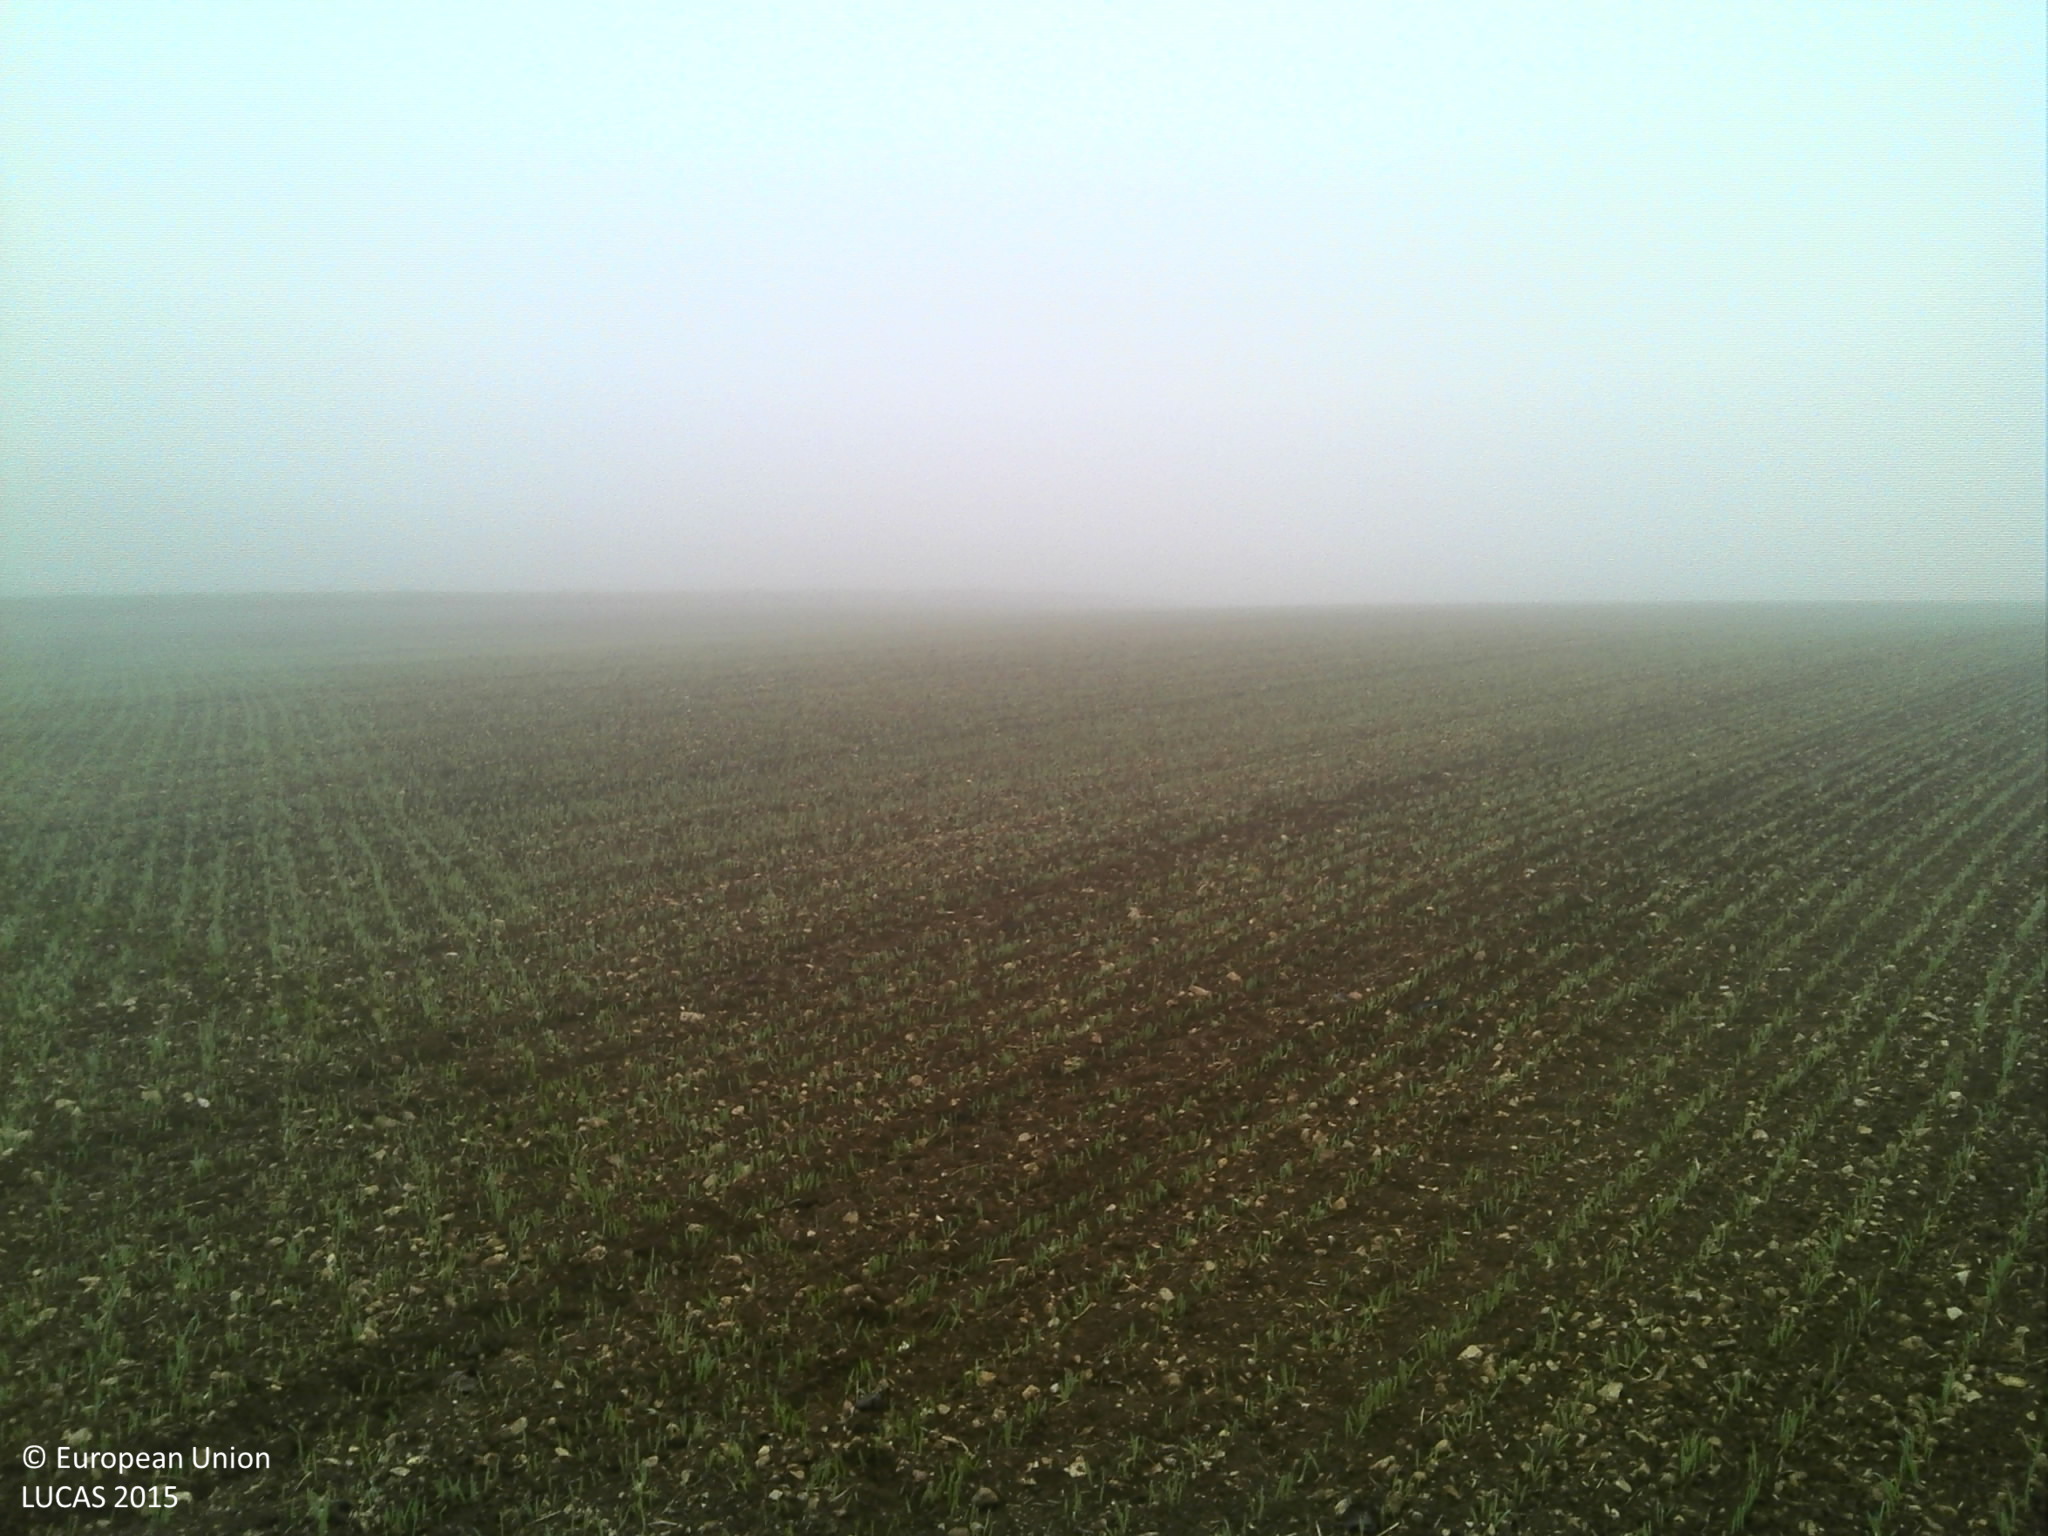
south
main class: Cropland
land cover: Common wheat
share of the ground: 10 - 25 %
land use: Agriculture (excluding fallow land and kitchen gardens)
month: October
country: FR
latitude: 47.4299
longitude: 5.1083
